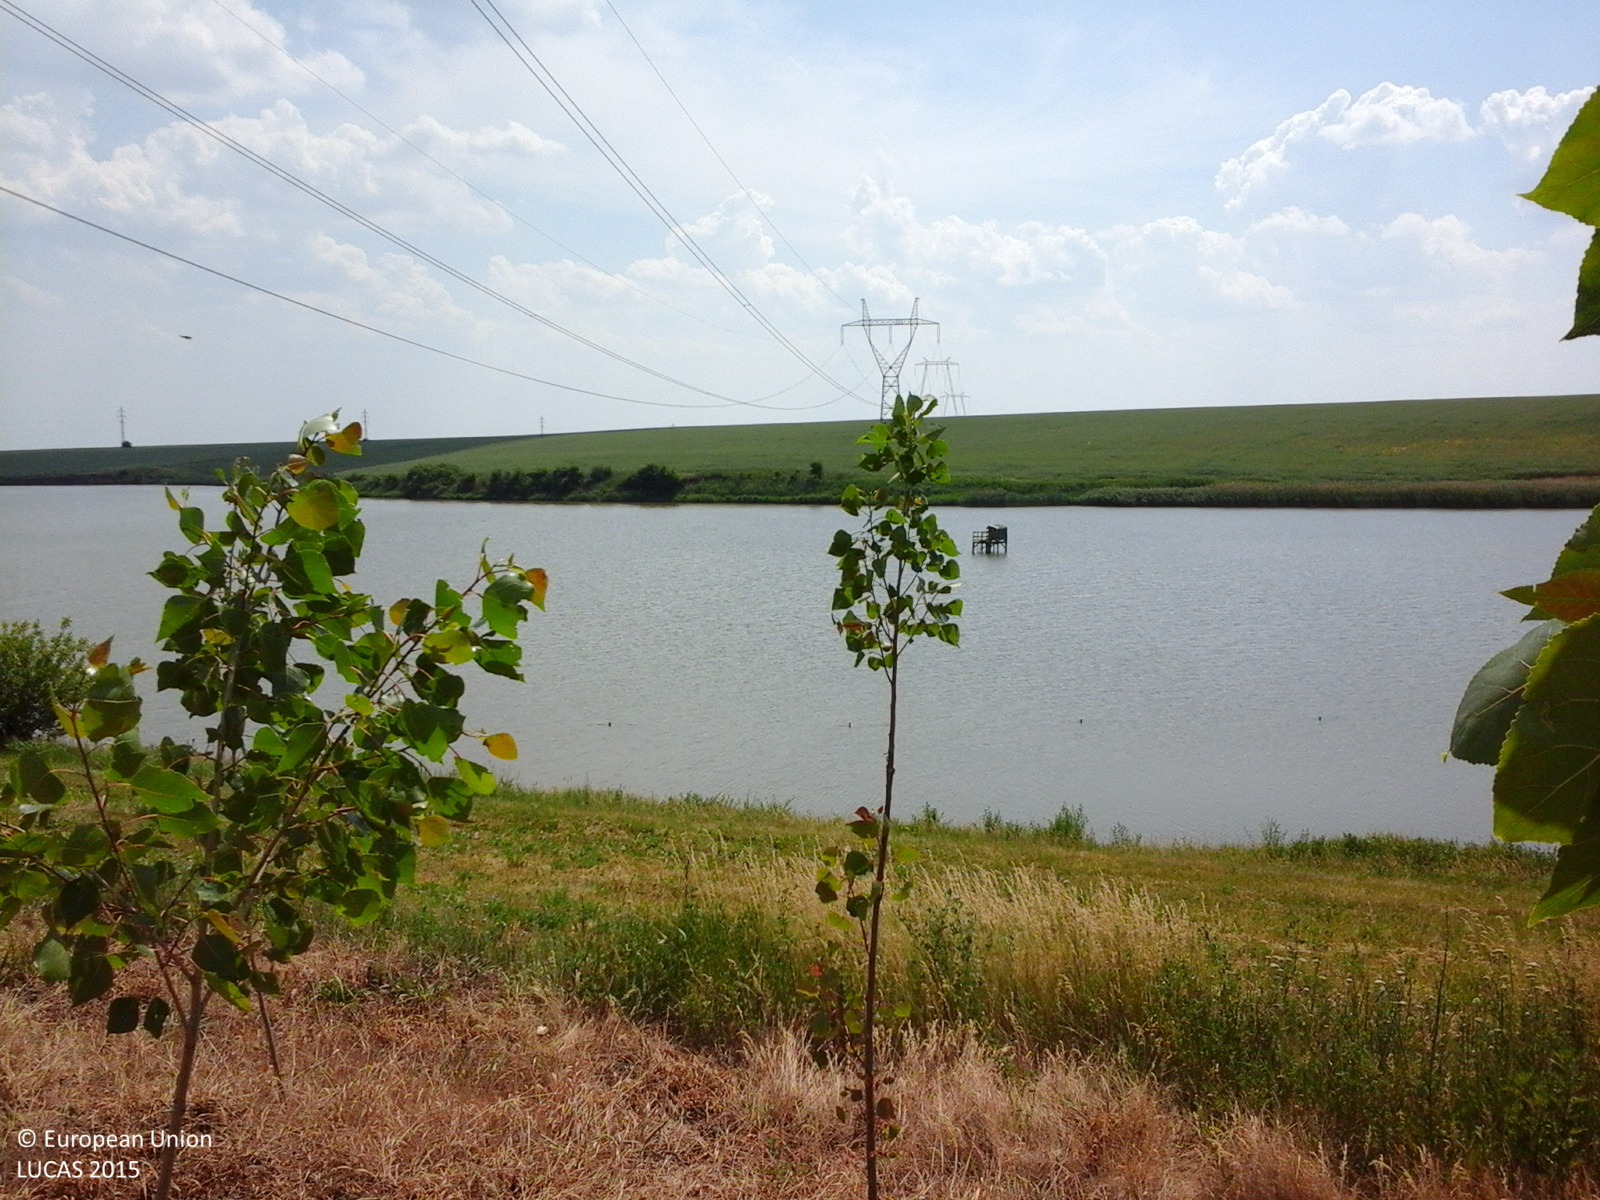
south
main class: Woodland
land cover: Broadleaved woodland
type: non-riverine alder, birch or aspen forest
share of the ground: 10 - 25 %
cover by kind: herbaceous plants 60 %, broadleaved forest trees 40 %
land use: Forestry
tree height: < 5 m
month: June
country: RO
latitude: 46.9162
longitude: 26.8359
